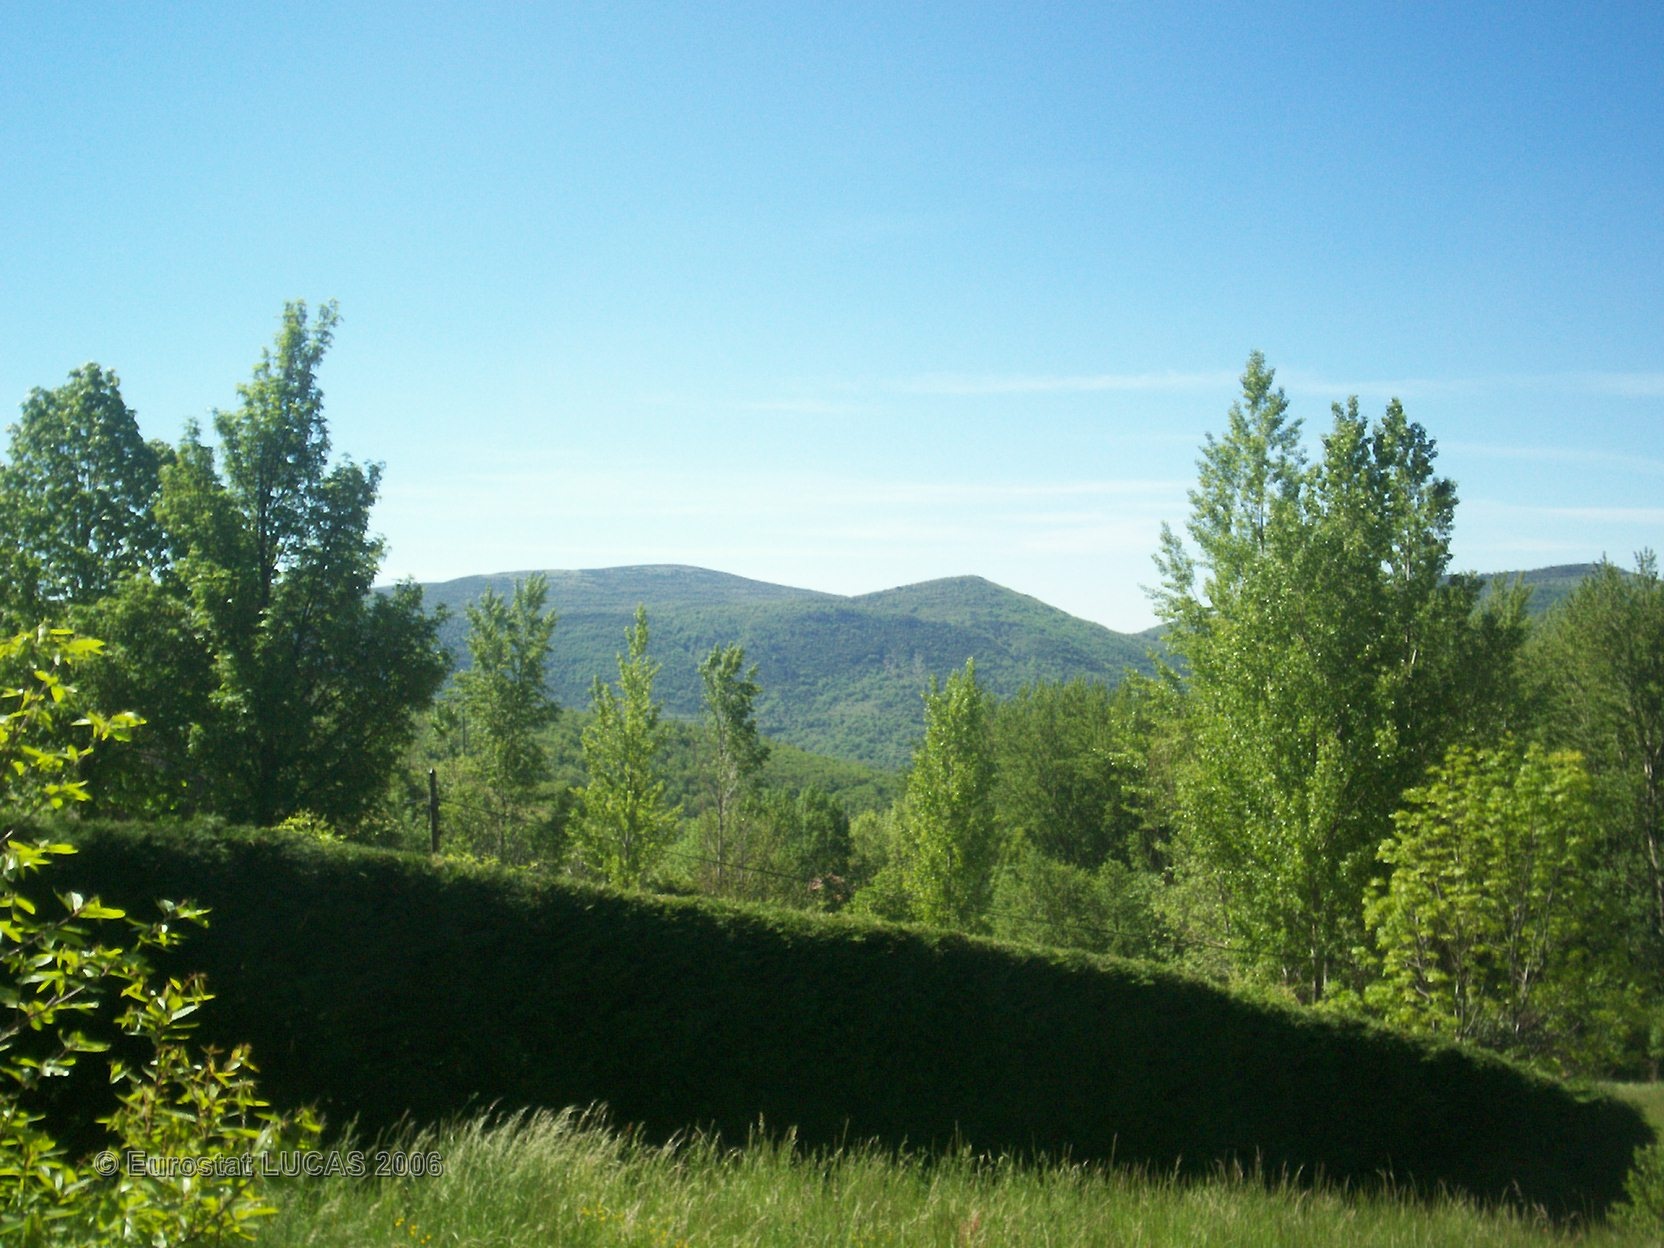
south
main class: Grassland
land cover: Grassland with sparse tree/shrub cover
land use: Residential
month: May
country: FR
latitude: 44.0010
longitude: 3.4848
